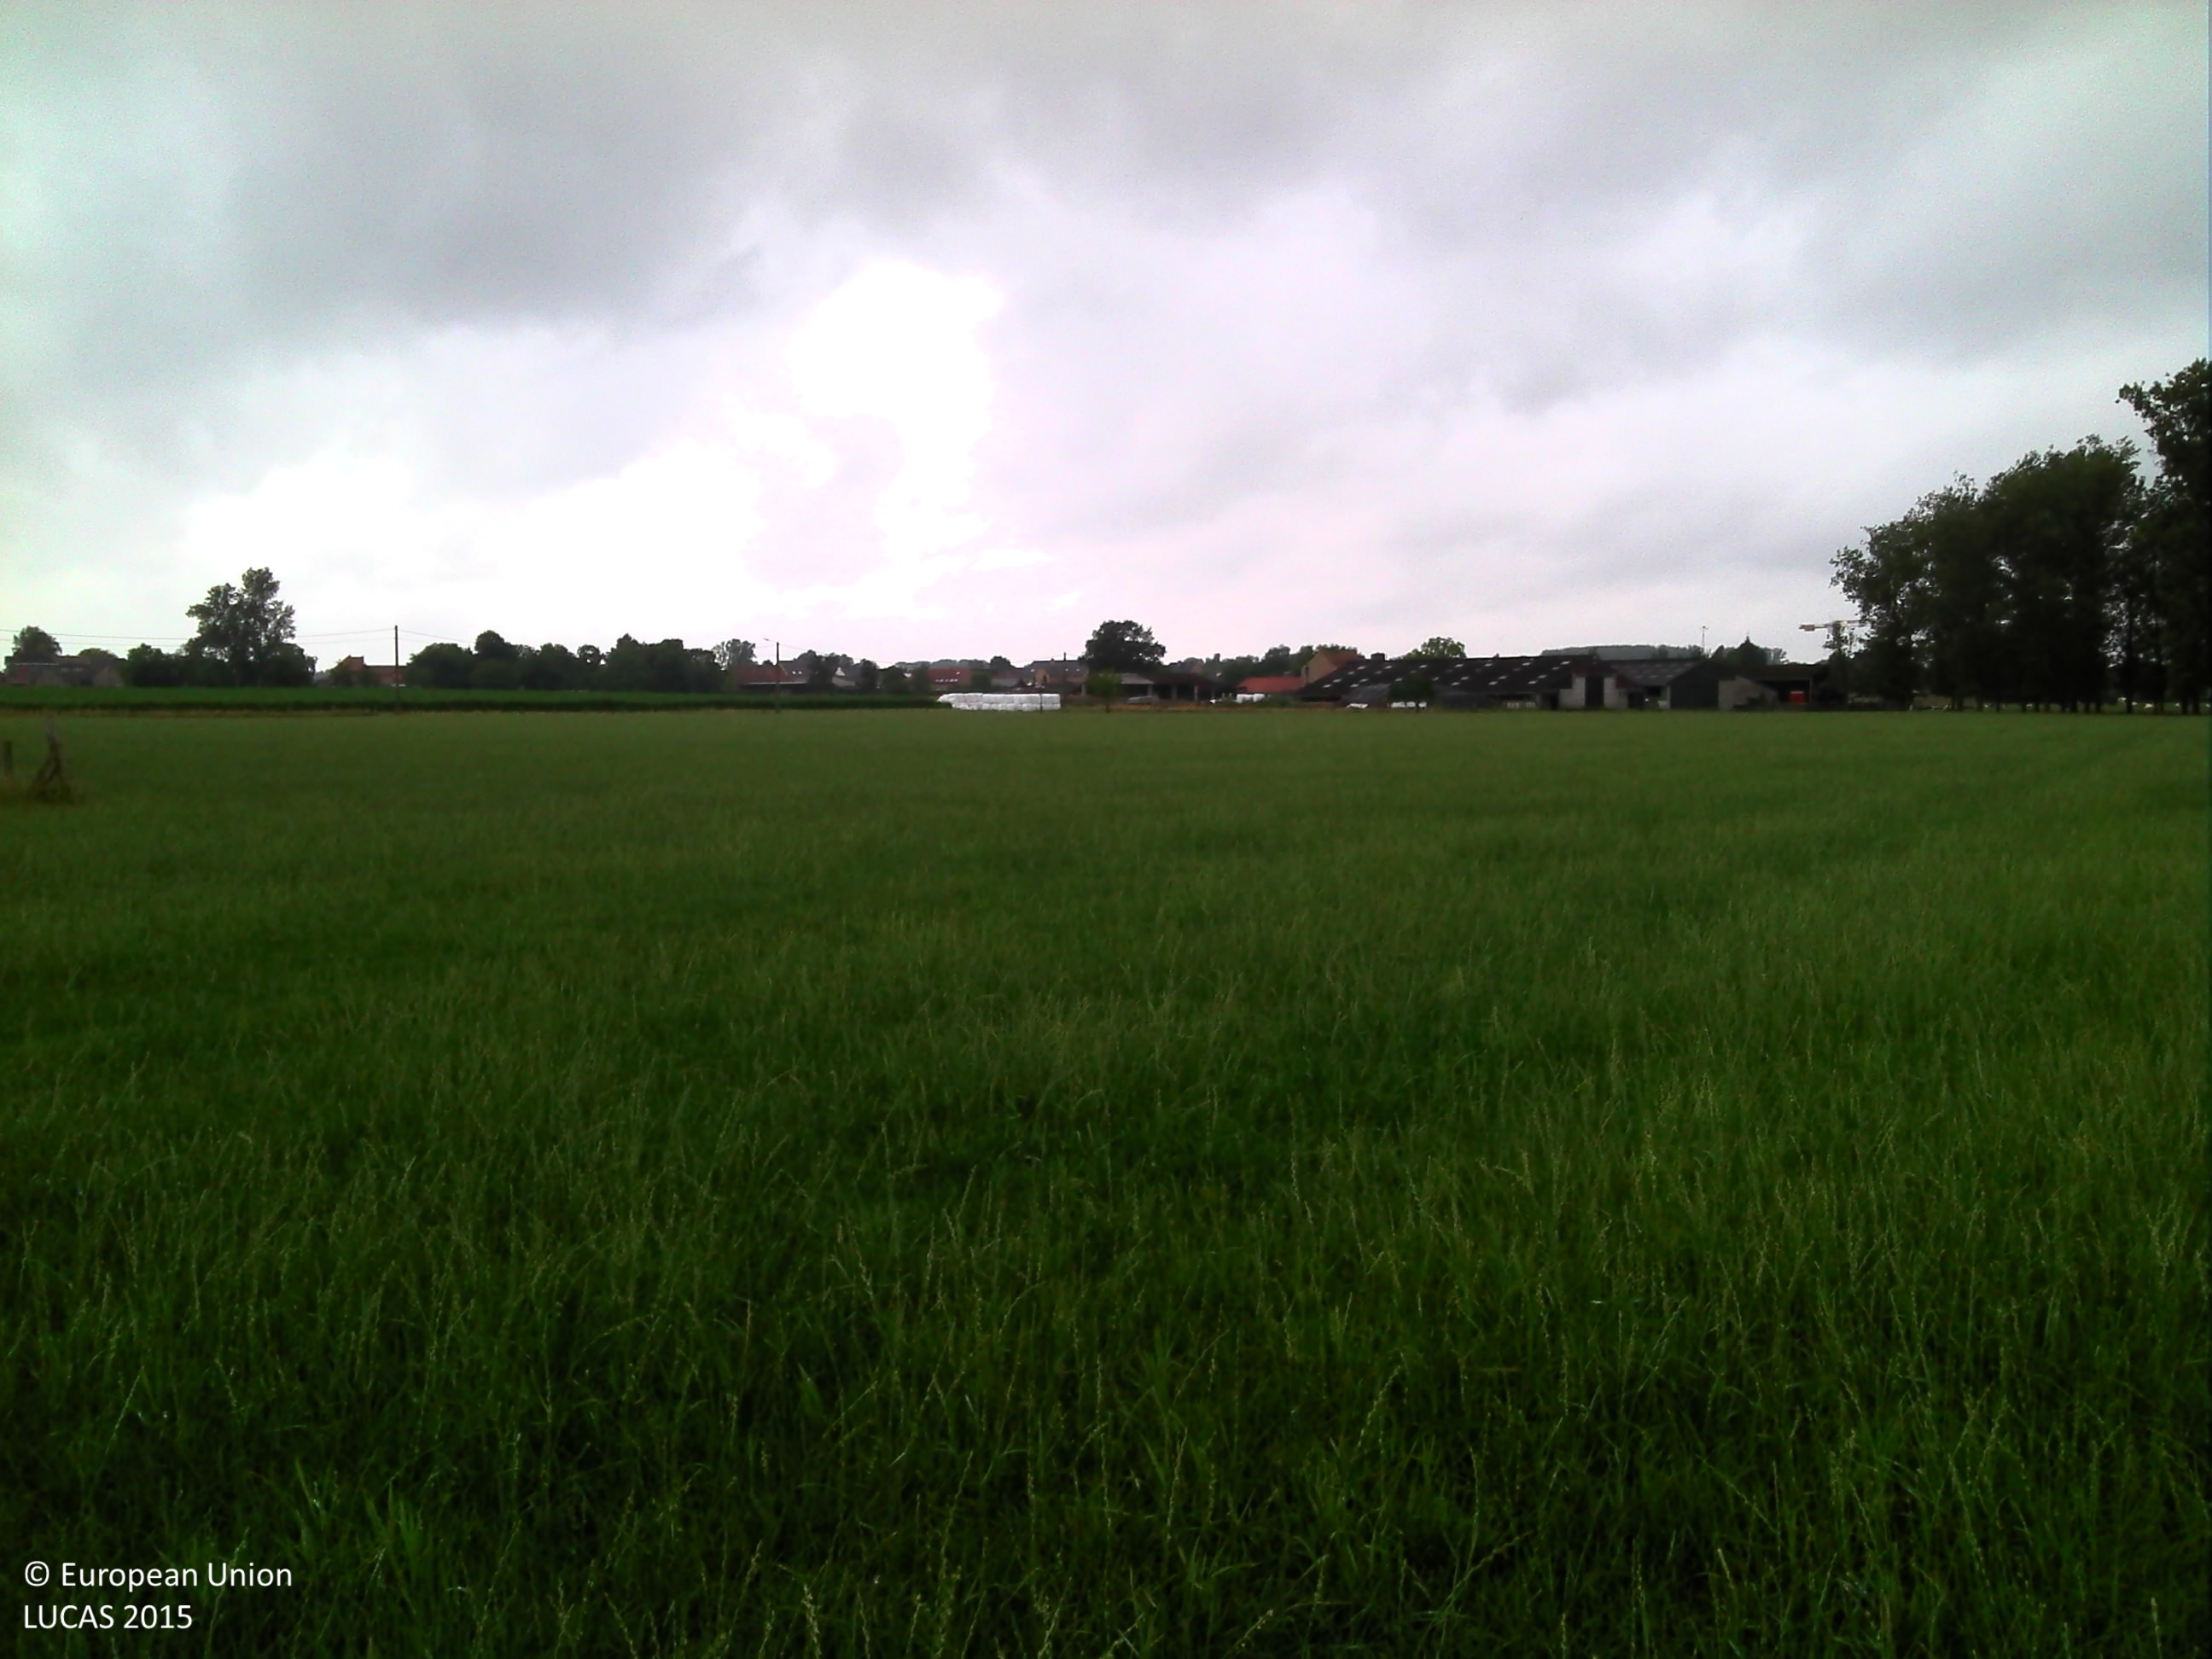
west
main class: Cropland
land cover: Temporary grasslands
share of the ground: > 75 %
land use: Agriculture (excluding fallow land and kitchen gardens)
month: July
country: BE
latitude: 50.8875
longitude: 5.4919
